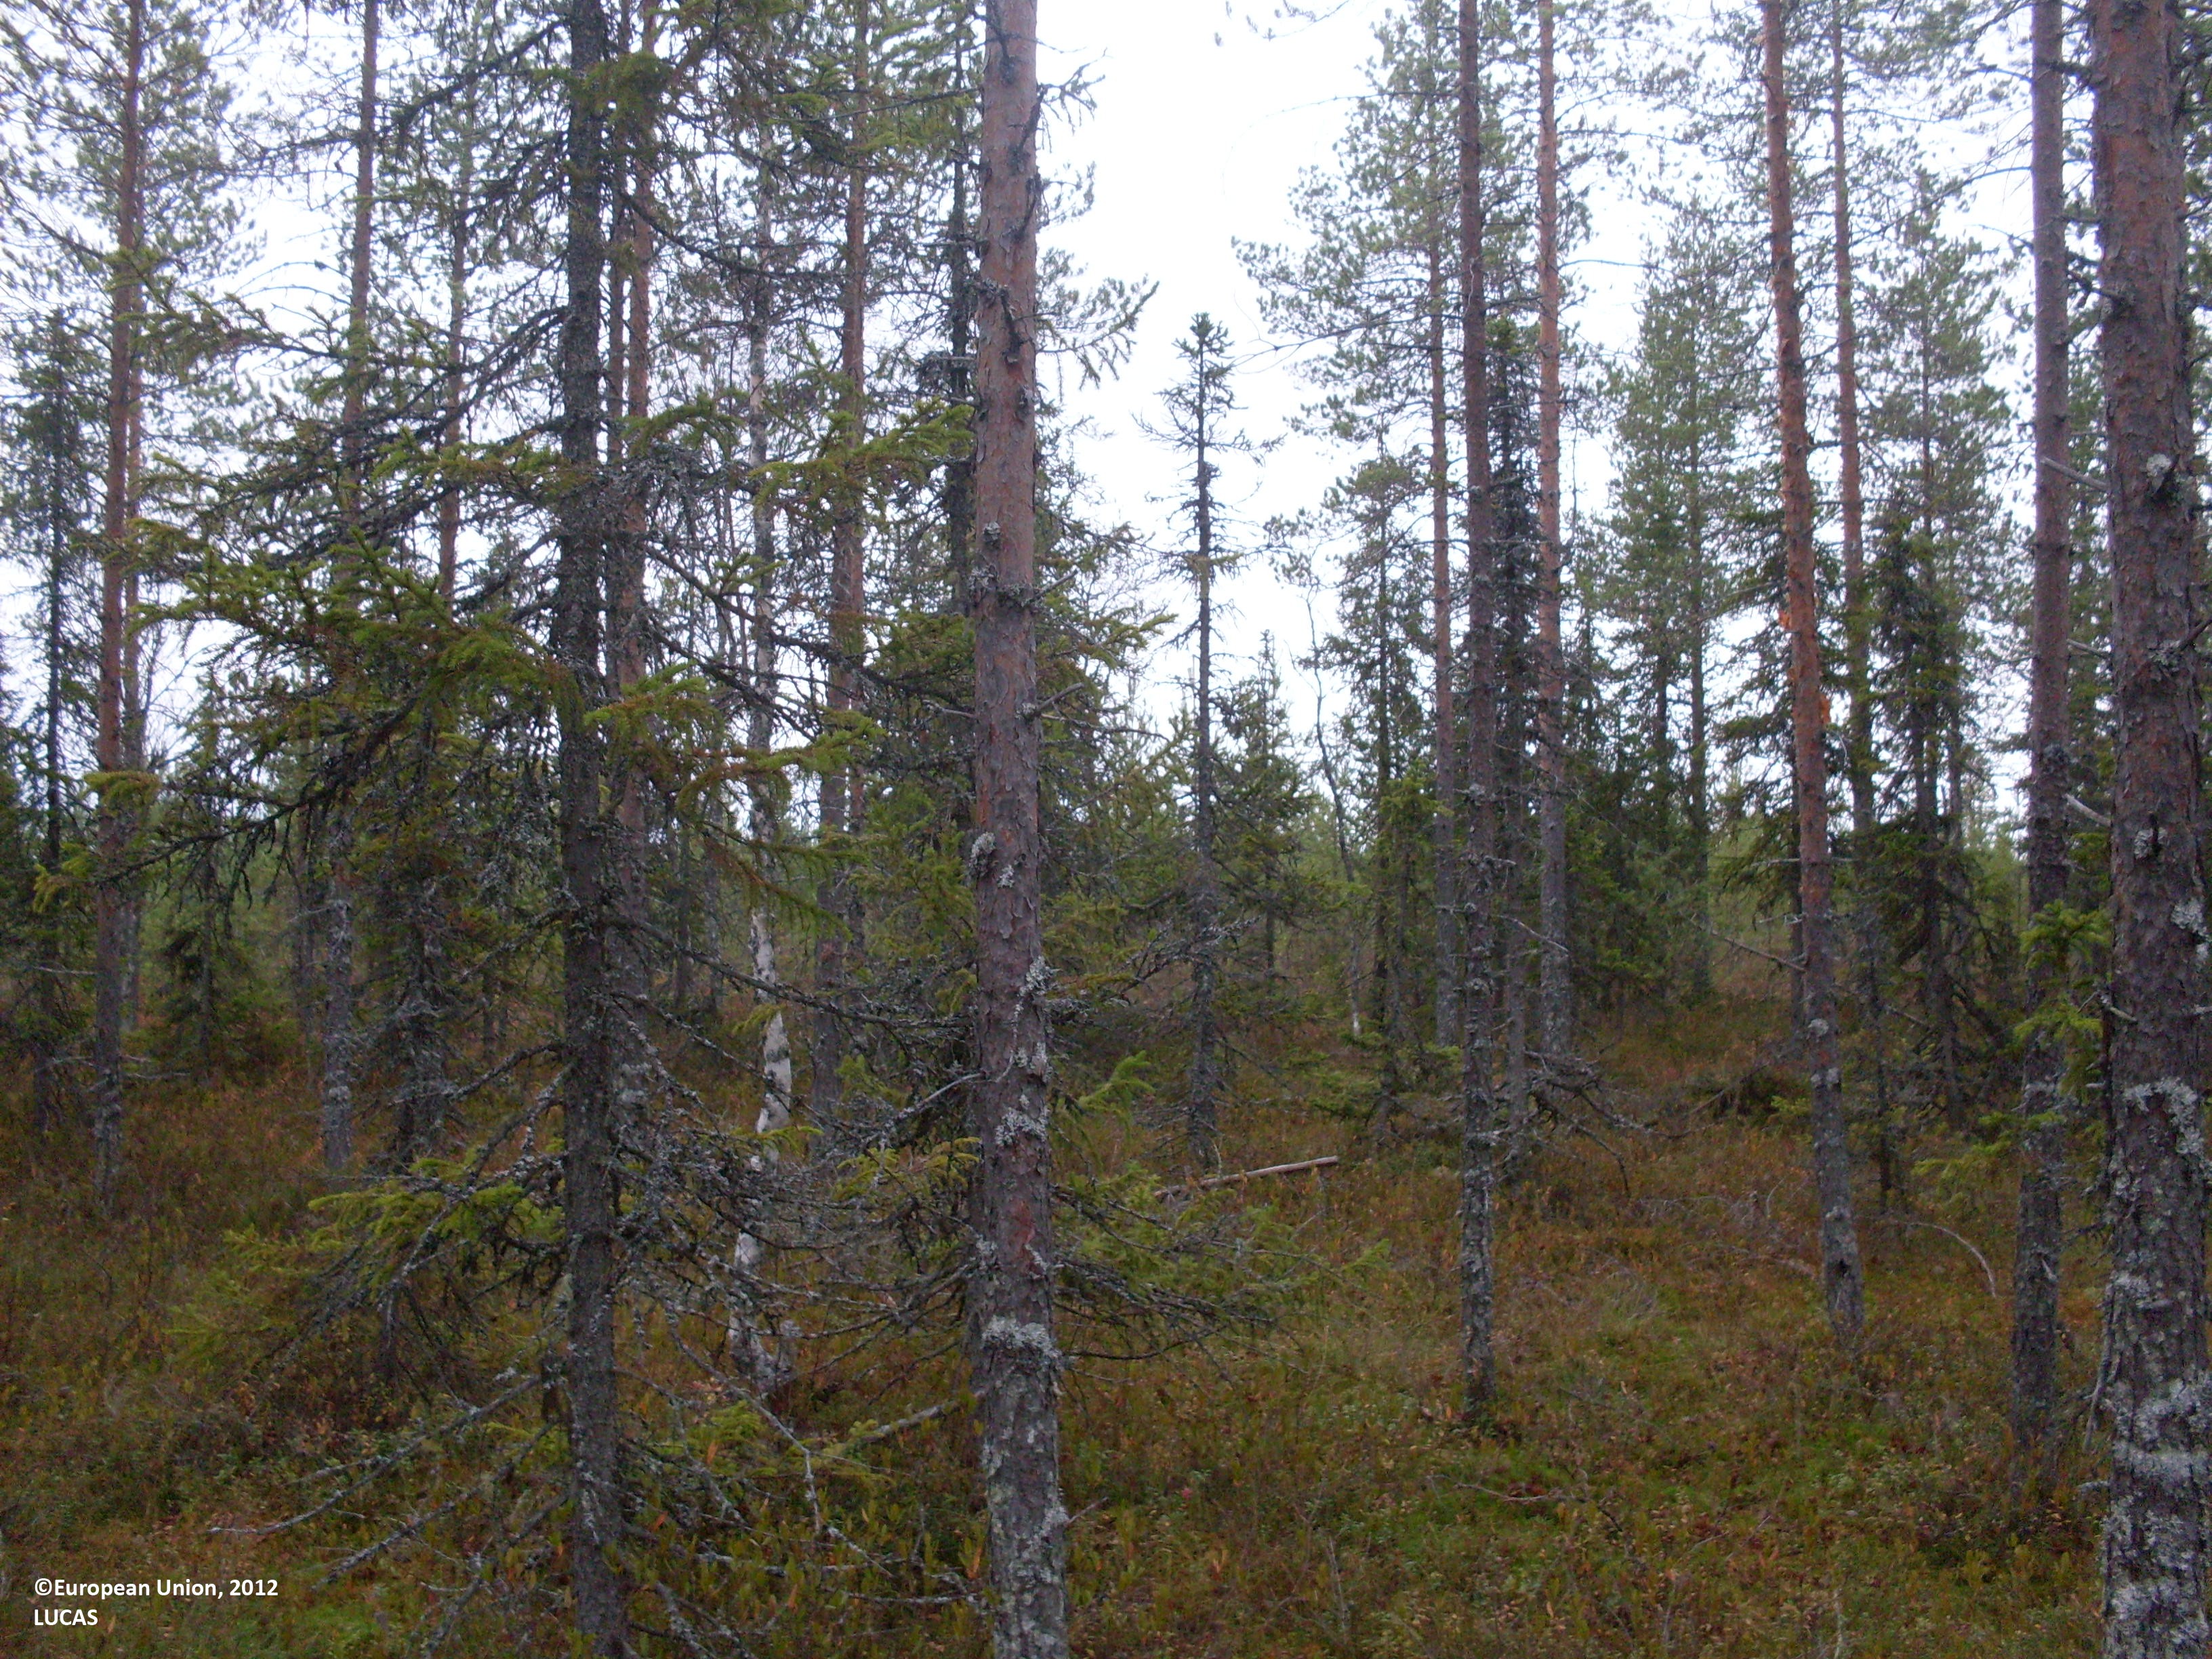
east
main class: Woodland
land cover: Pine dominated coniferous woodland
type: boreal forest
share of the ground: 25 - 50 %
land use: Forestry
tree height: > 5 m
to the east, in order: Pine dominated coniferous woodland; Inland marshes; Inland running water; Inland marshes; Pine dominated coniferous woodland
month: September
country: FI
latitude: 64.5513
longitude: 29.6800
